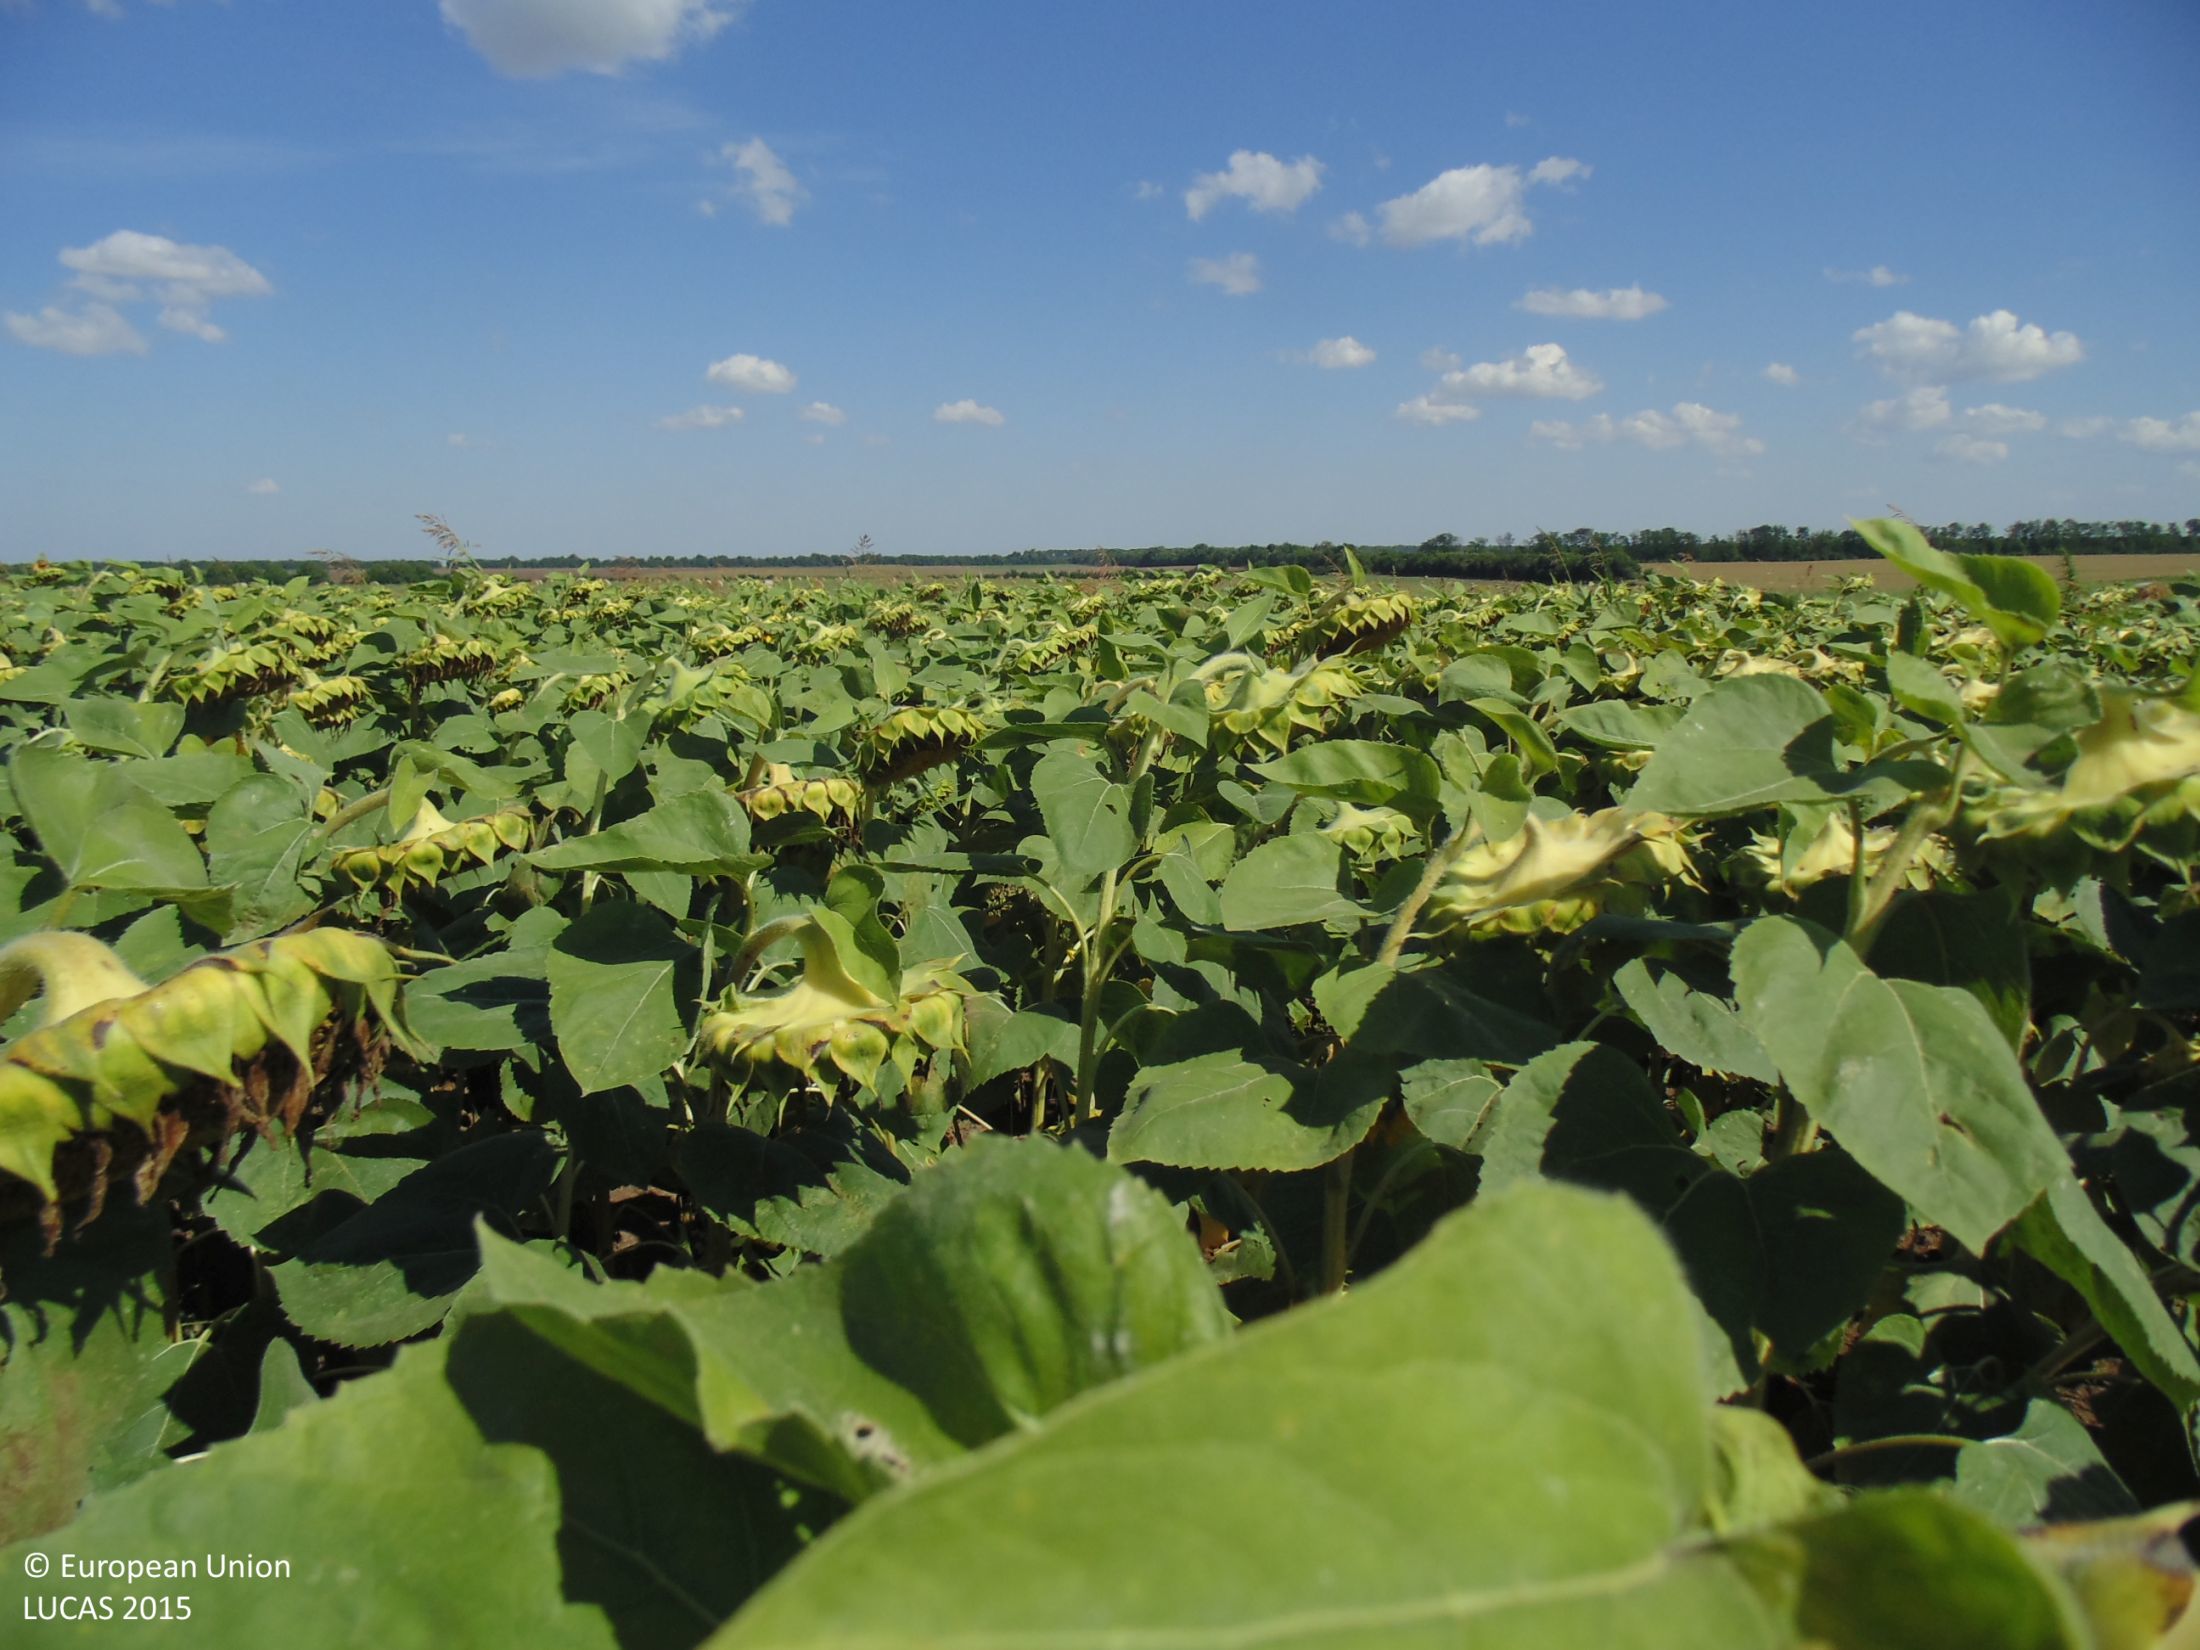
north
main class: Cropland
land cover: Sunflower
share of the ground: > 75 %
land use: Agriculture (excluding fallow land and kitchen gardens)
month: August
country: BG
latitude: 43.7437
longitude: 27.8645
